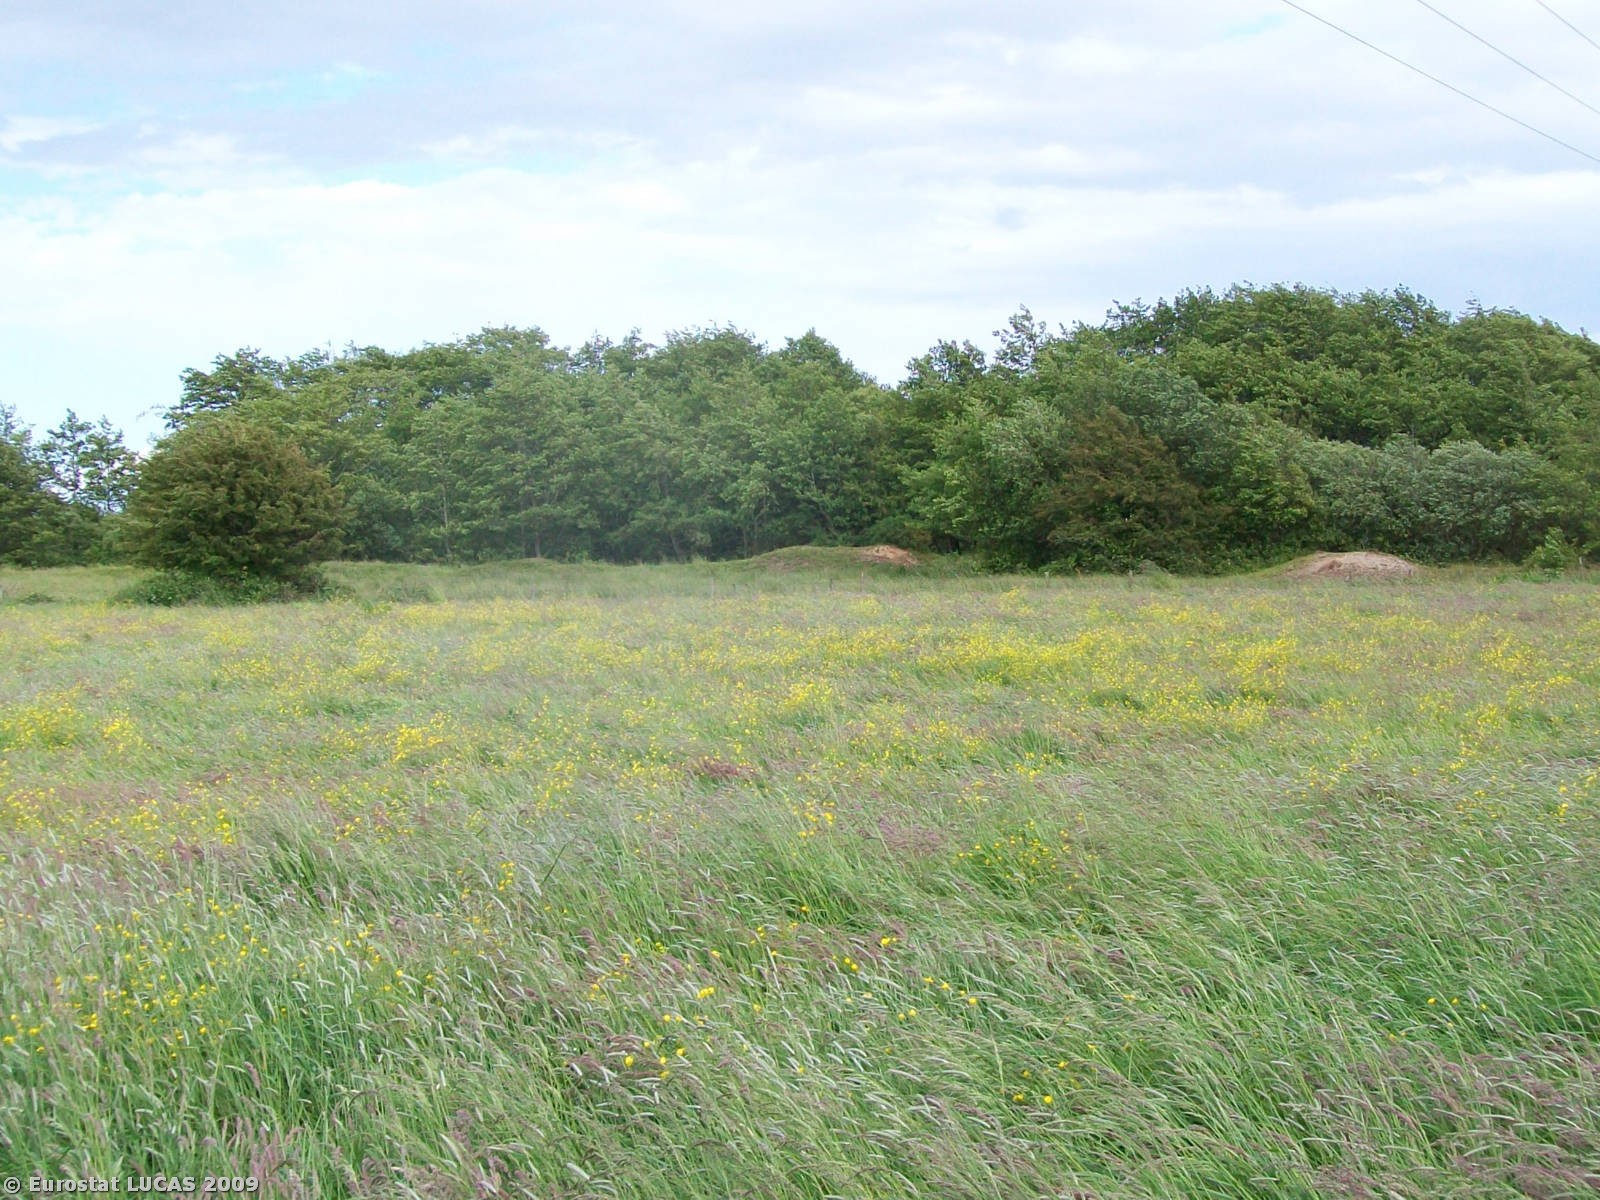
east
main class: Grassland
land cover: Grassland without tree/shrub cover
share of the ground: > 75 %
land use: Agriculture (excluding fallow land and kitchen gardens)
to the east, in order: Grassland without tree/shrub cover; Electric lines; Grassland without tree/shrub cover; Fences; Ditches and canals; Fences; Grassland without tree/shrub cover; Lines of trees; Inland water bodies; Broadleaved woodland; Inland water bodies; Broadleaved woodland; Inland water bodies; Broadleaved woodland; Inland water bodies; Broadleaved woodland; Inland water bodies
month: June
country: GB
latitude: 54.8448
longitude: -3.2033
